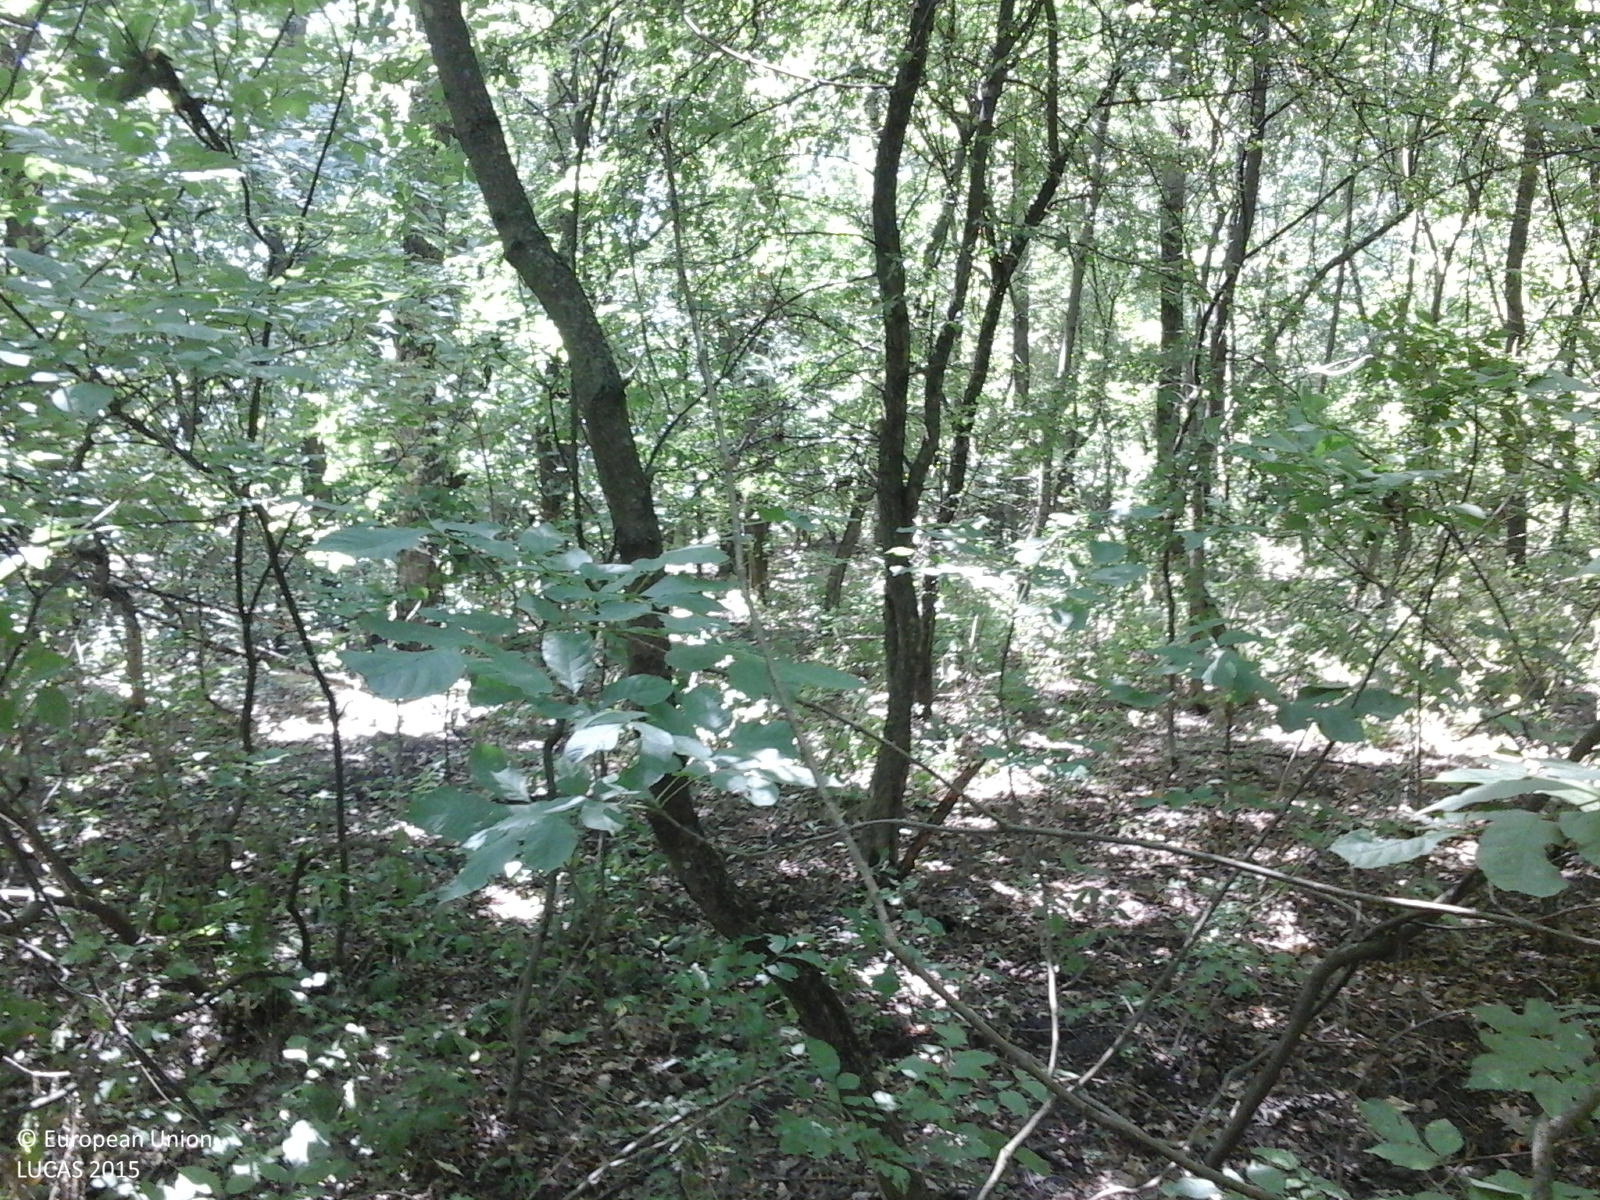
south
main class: Woodland
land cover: Broadleaved woodland
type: acidophilous oak and oak-birch forest
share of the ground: > 75 %
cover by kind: broadleaved forest trees 100 %
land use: Forestry
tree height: > 5 m
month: July
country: RO
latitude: 44.4130
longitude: 26.4004
